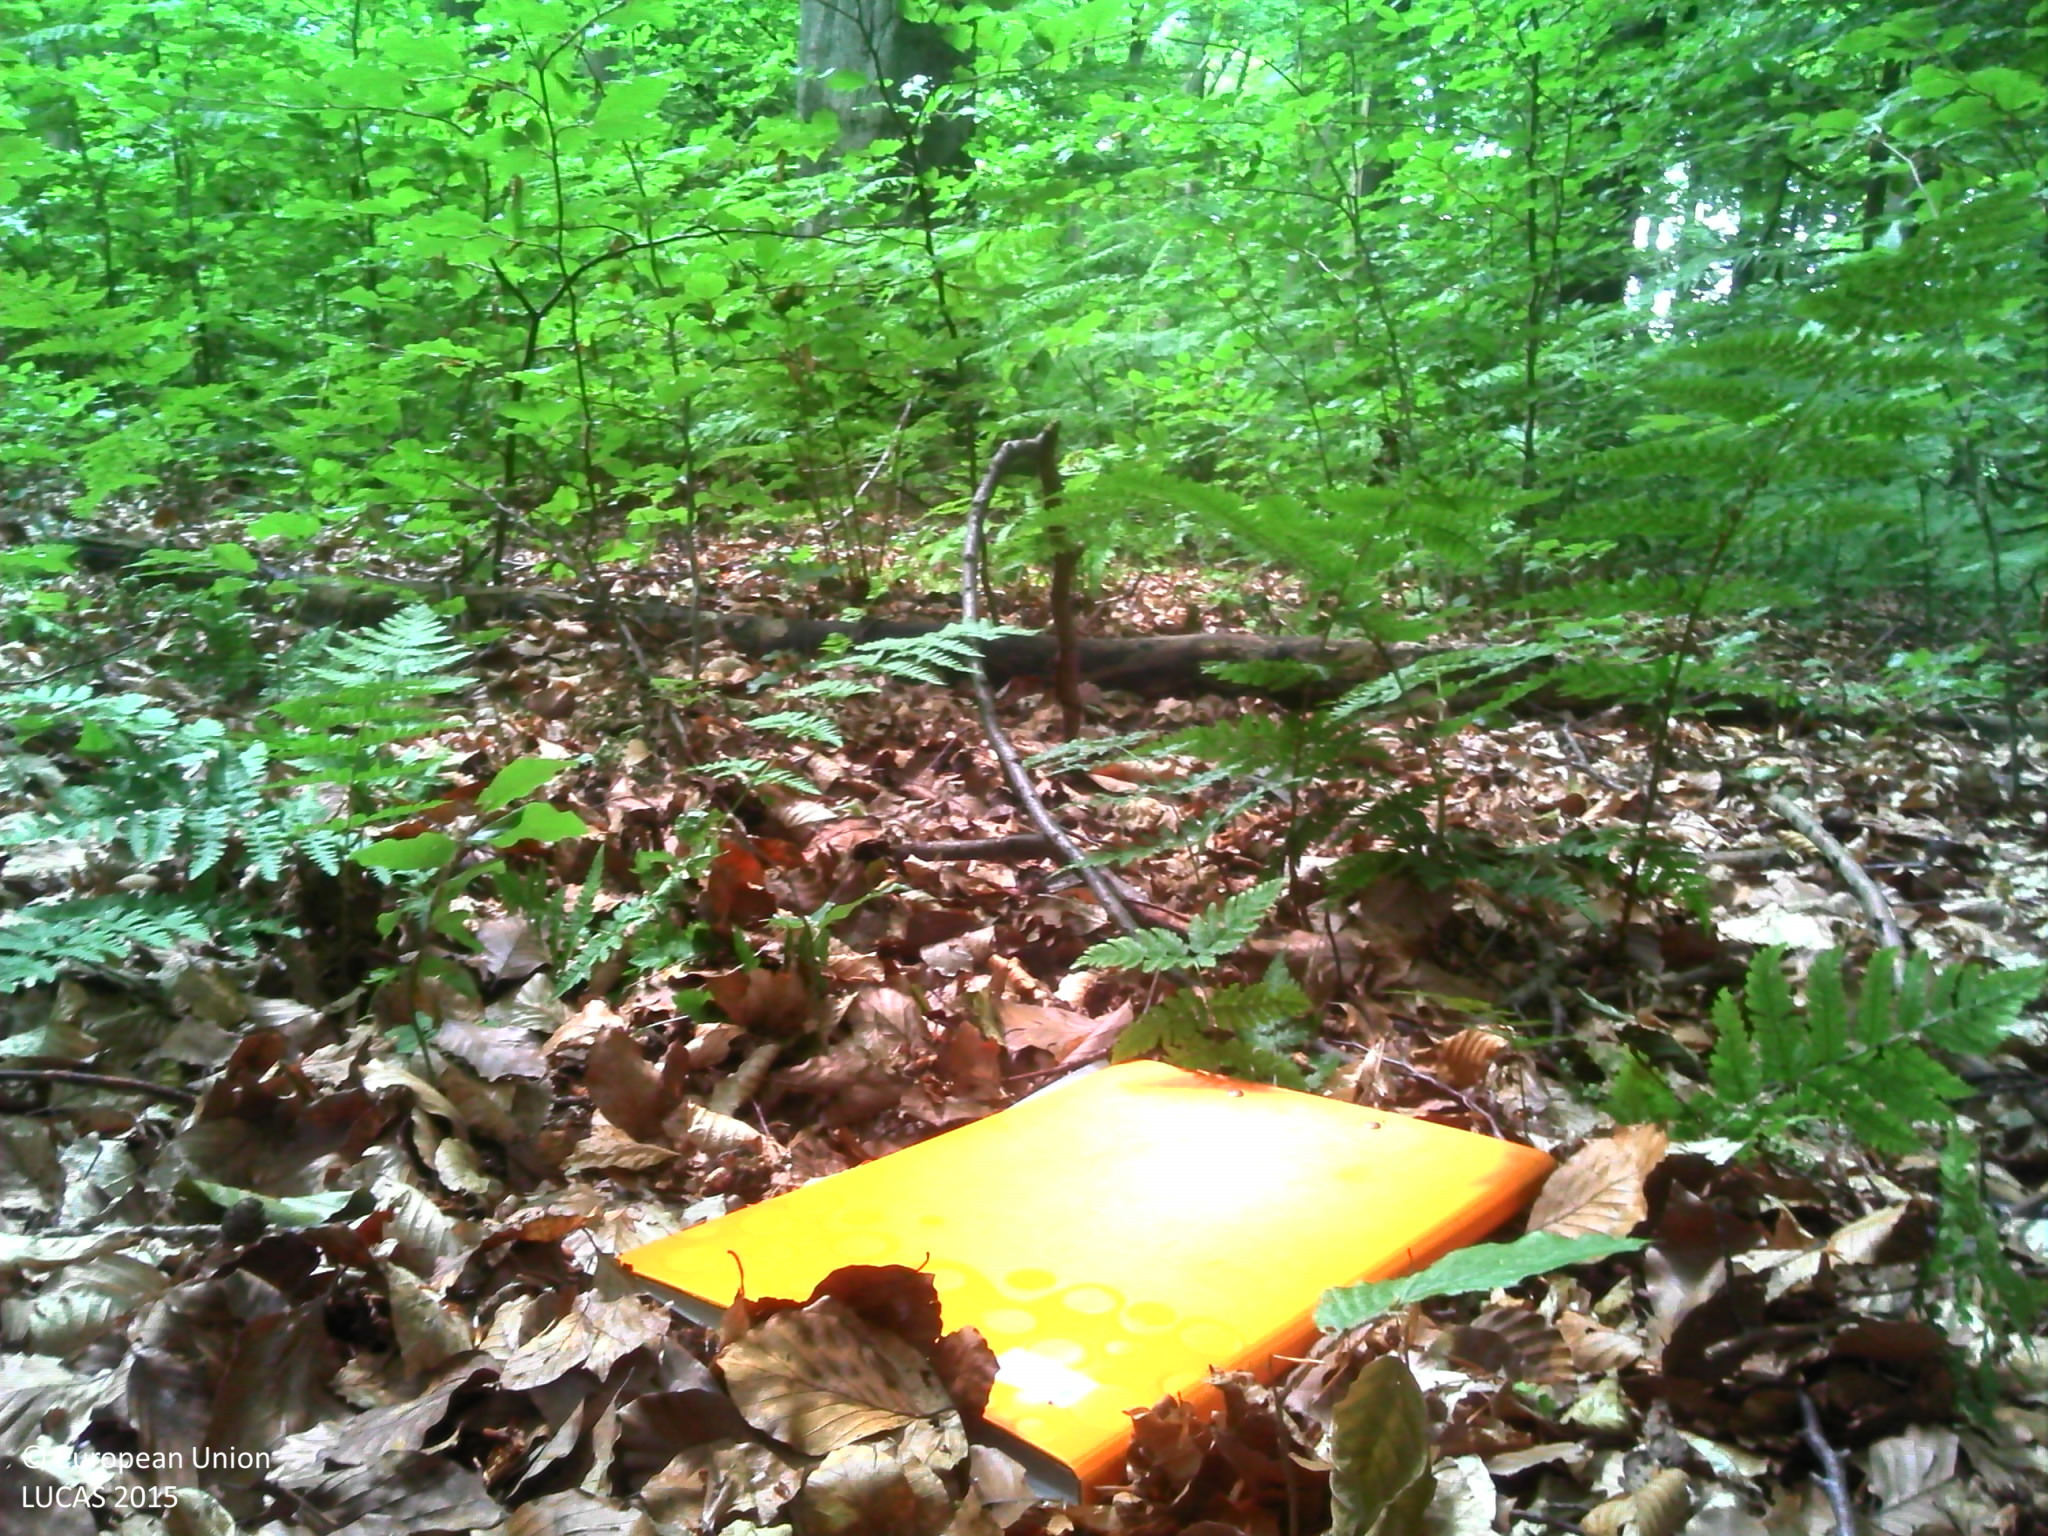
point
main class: Woodland
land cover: Broadleaved woodland
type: beech forest
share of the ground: > 75 %
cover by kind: broadleaved forest trees 90 %, herbaceous plants 5 %, lichens and mosses 5 %
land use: Forestry
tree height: > 5 m
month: July
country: BE
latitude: 50.7880
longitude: 4.4493
